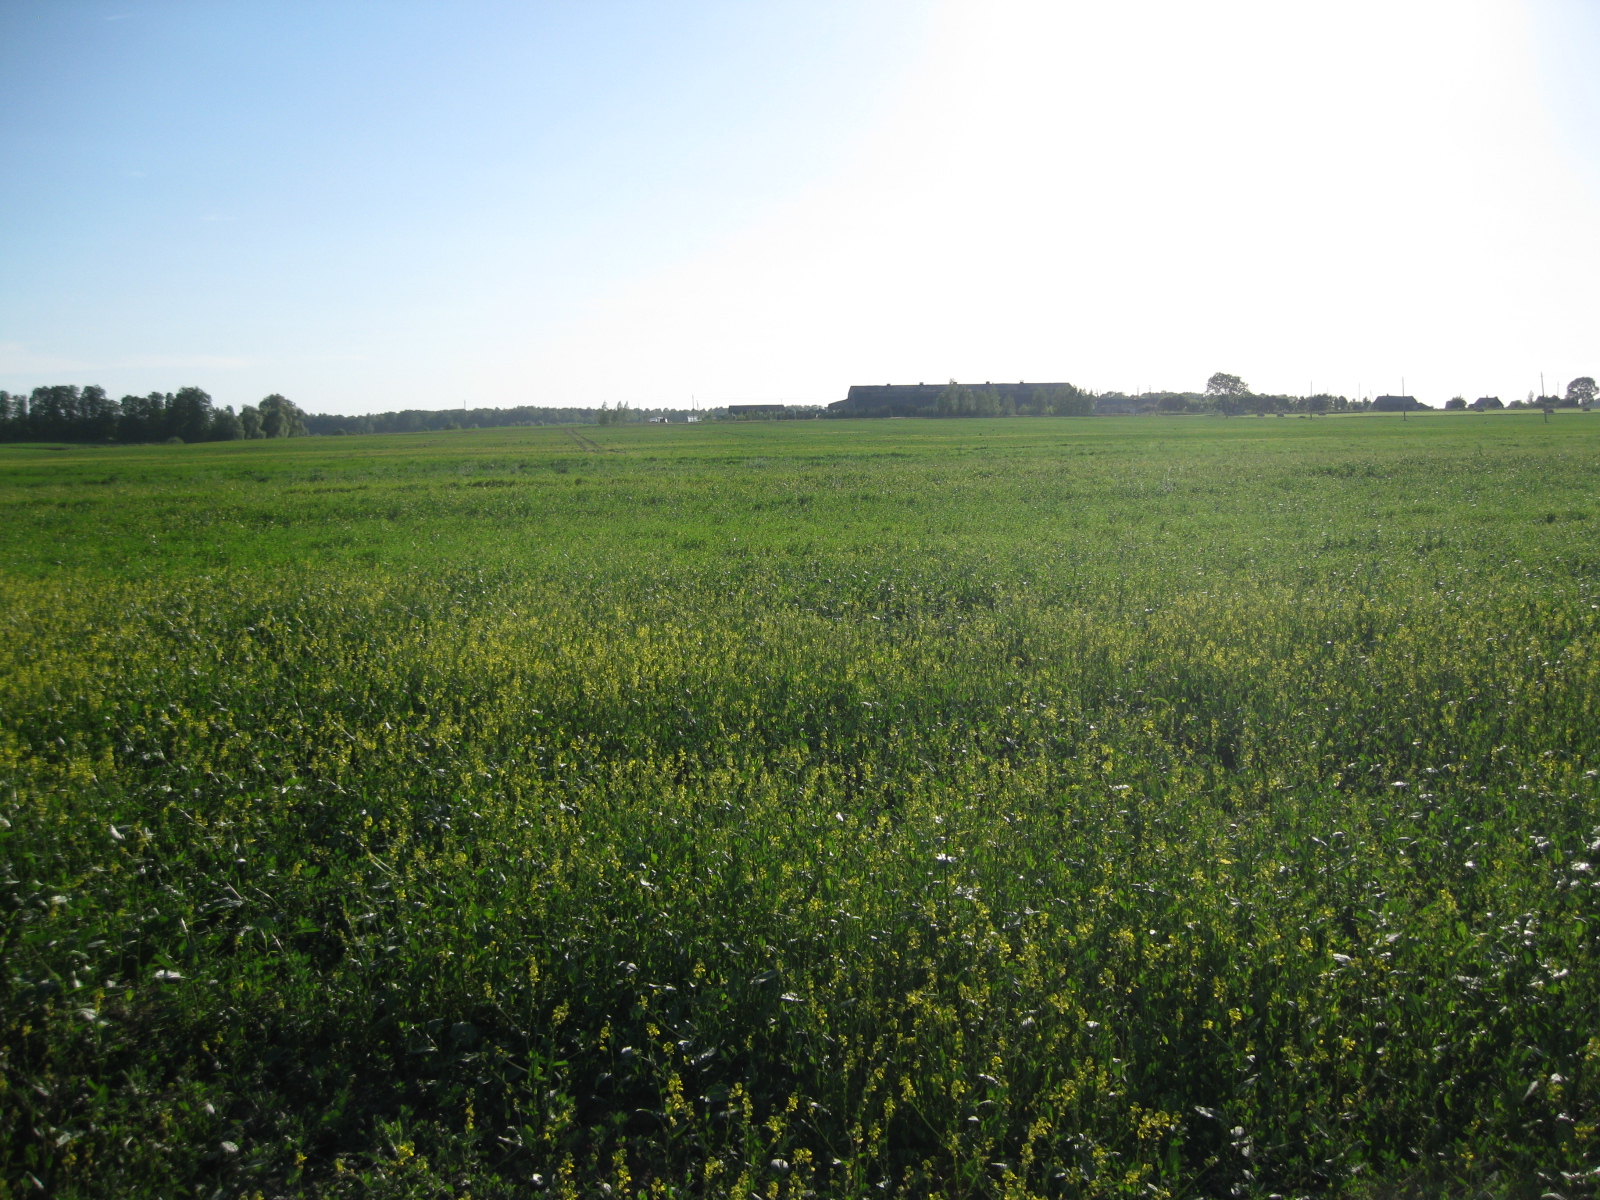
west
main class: Cropland
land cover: Rape and turnip rape
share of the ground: > 75 %
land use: Agriculture (excluding fallow land and kitchen gardens)
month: June
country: LT
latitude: 55.8043
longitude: 23.9511
